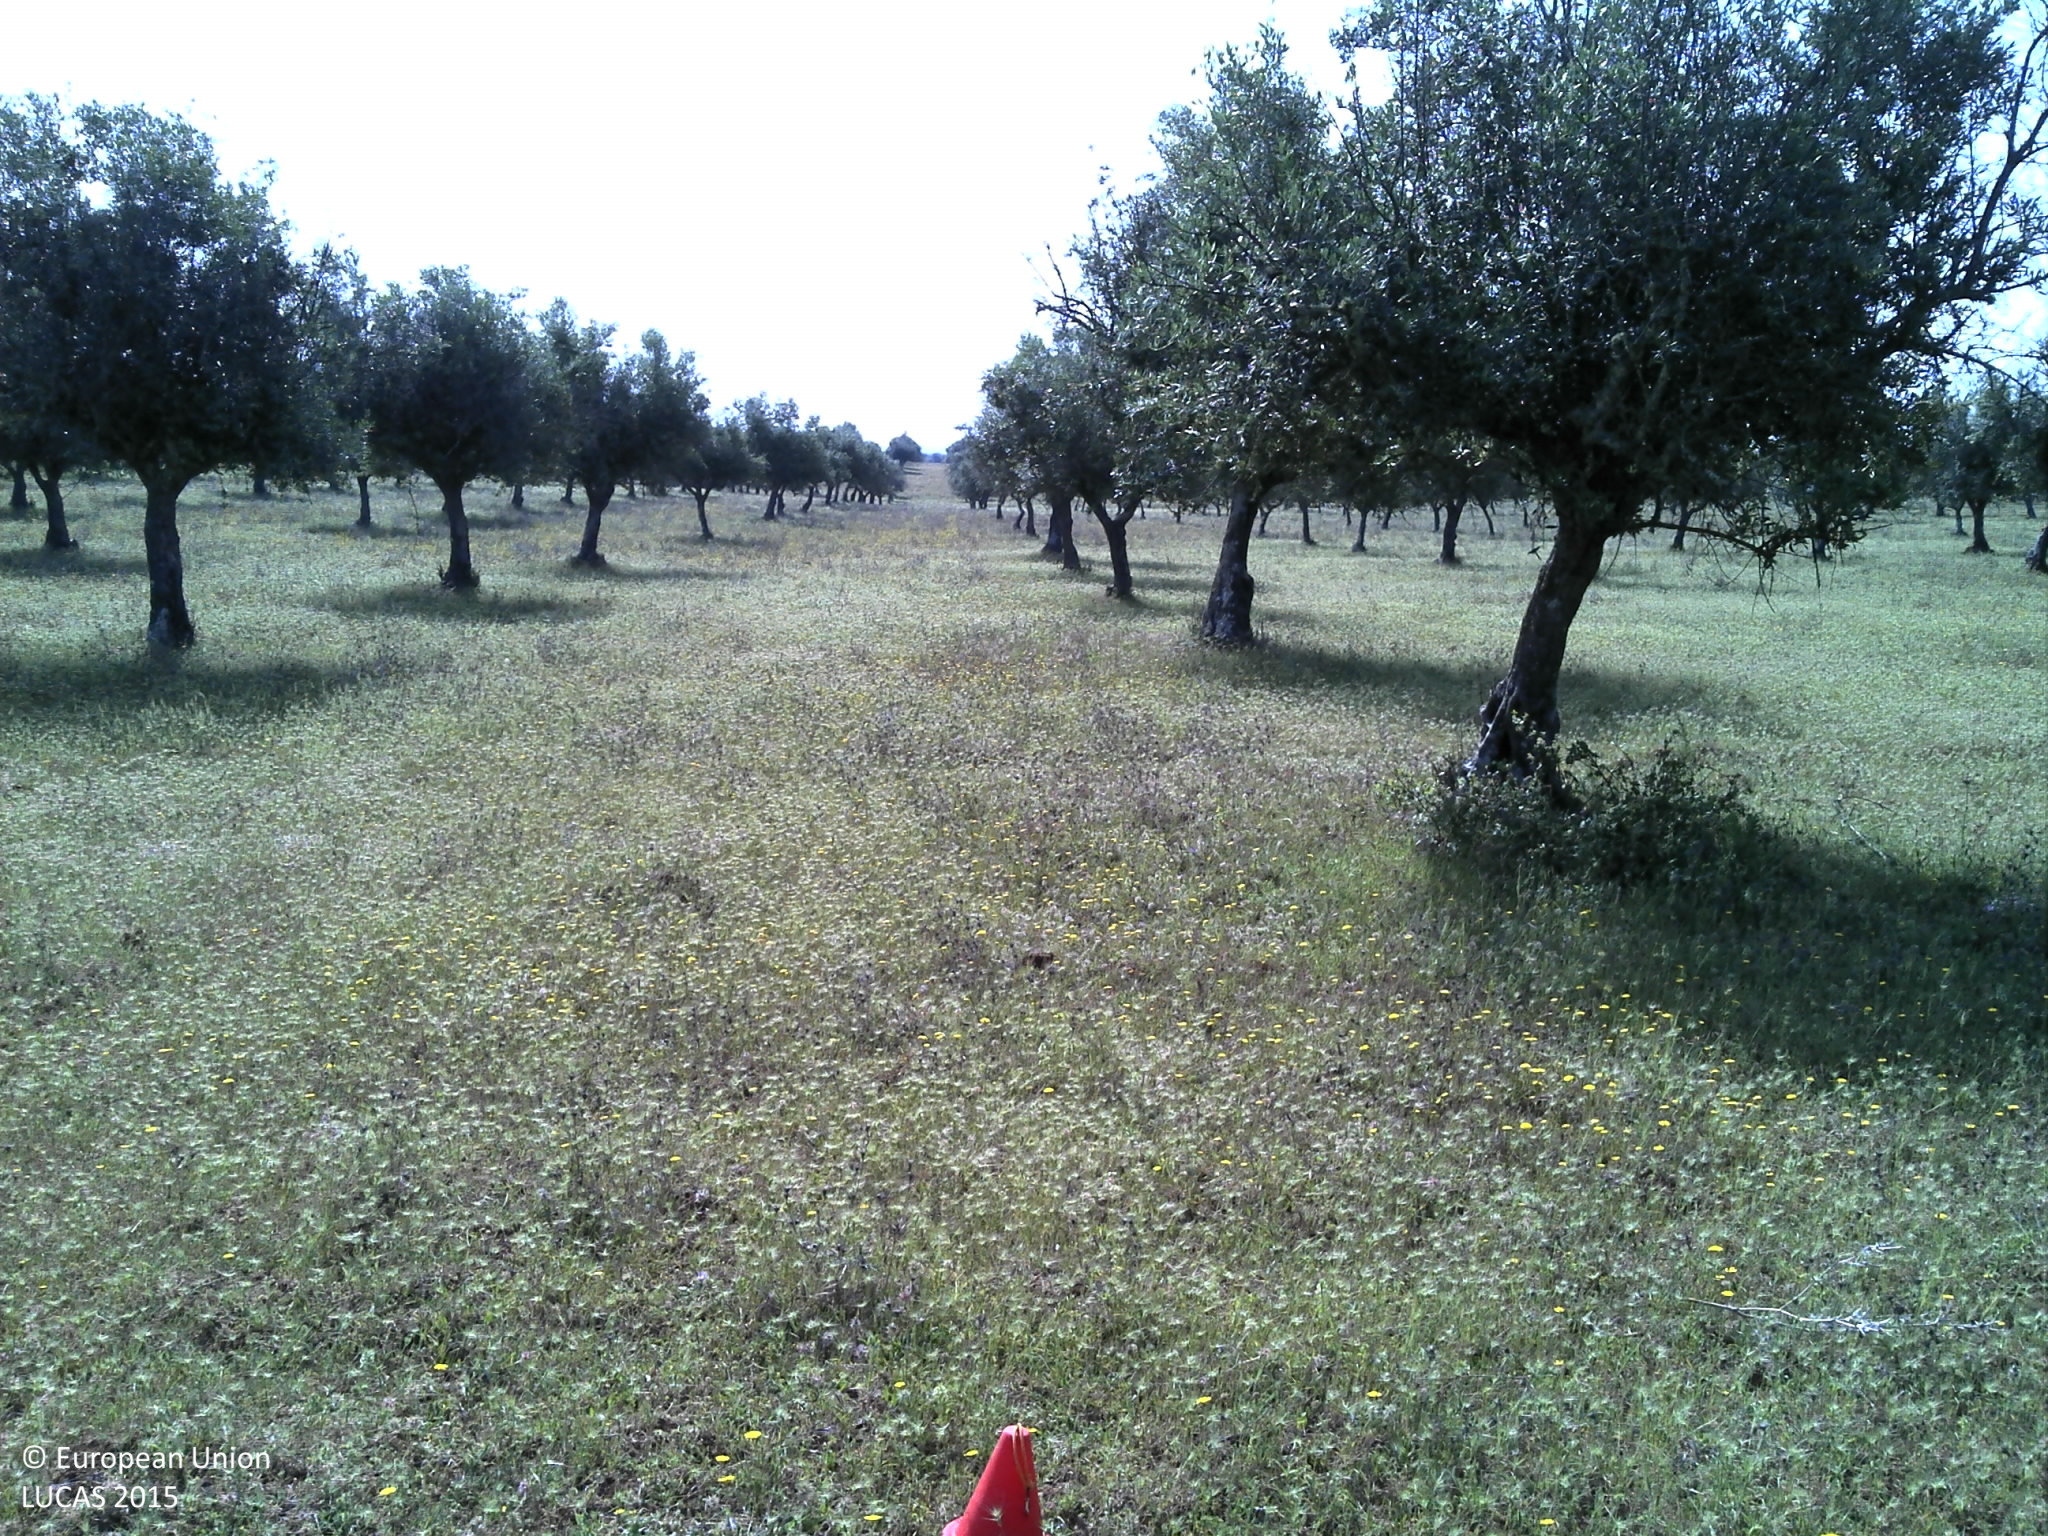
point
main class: Cropland
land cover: Olive groves
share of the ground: 25 - 50 %
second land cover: Grassland without tree/shrub cover
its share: 50 - 75 %
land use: Agriculture (excluding fallow land and kitchen gardens)
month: May
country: PT
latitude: 38.9918
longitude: -7.8134
